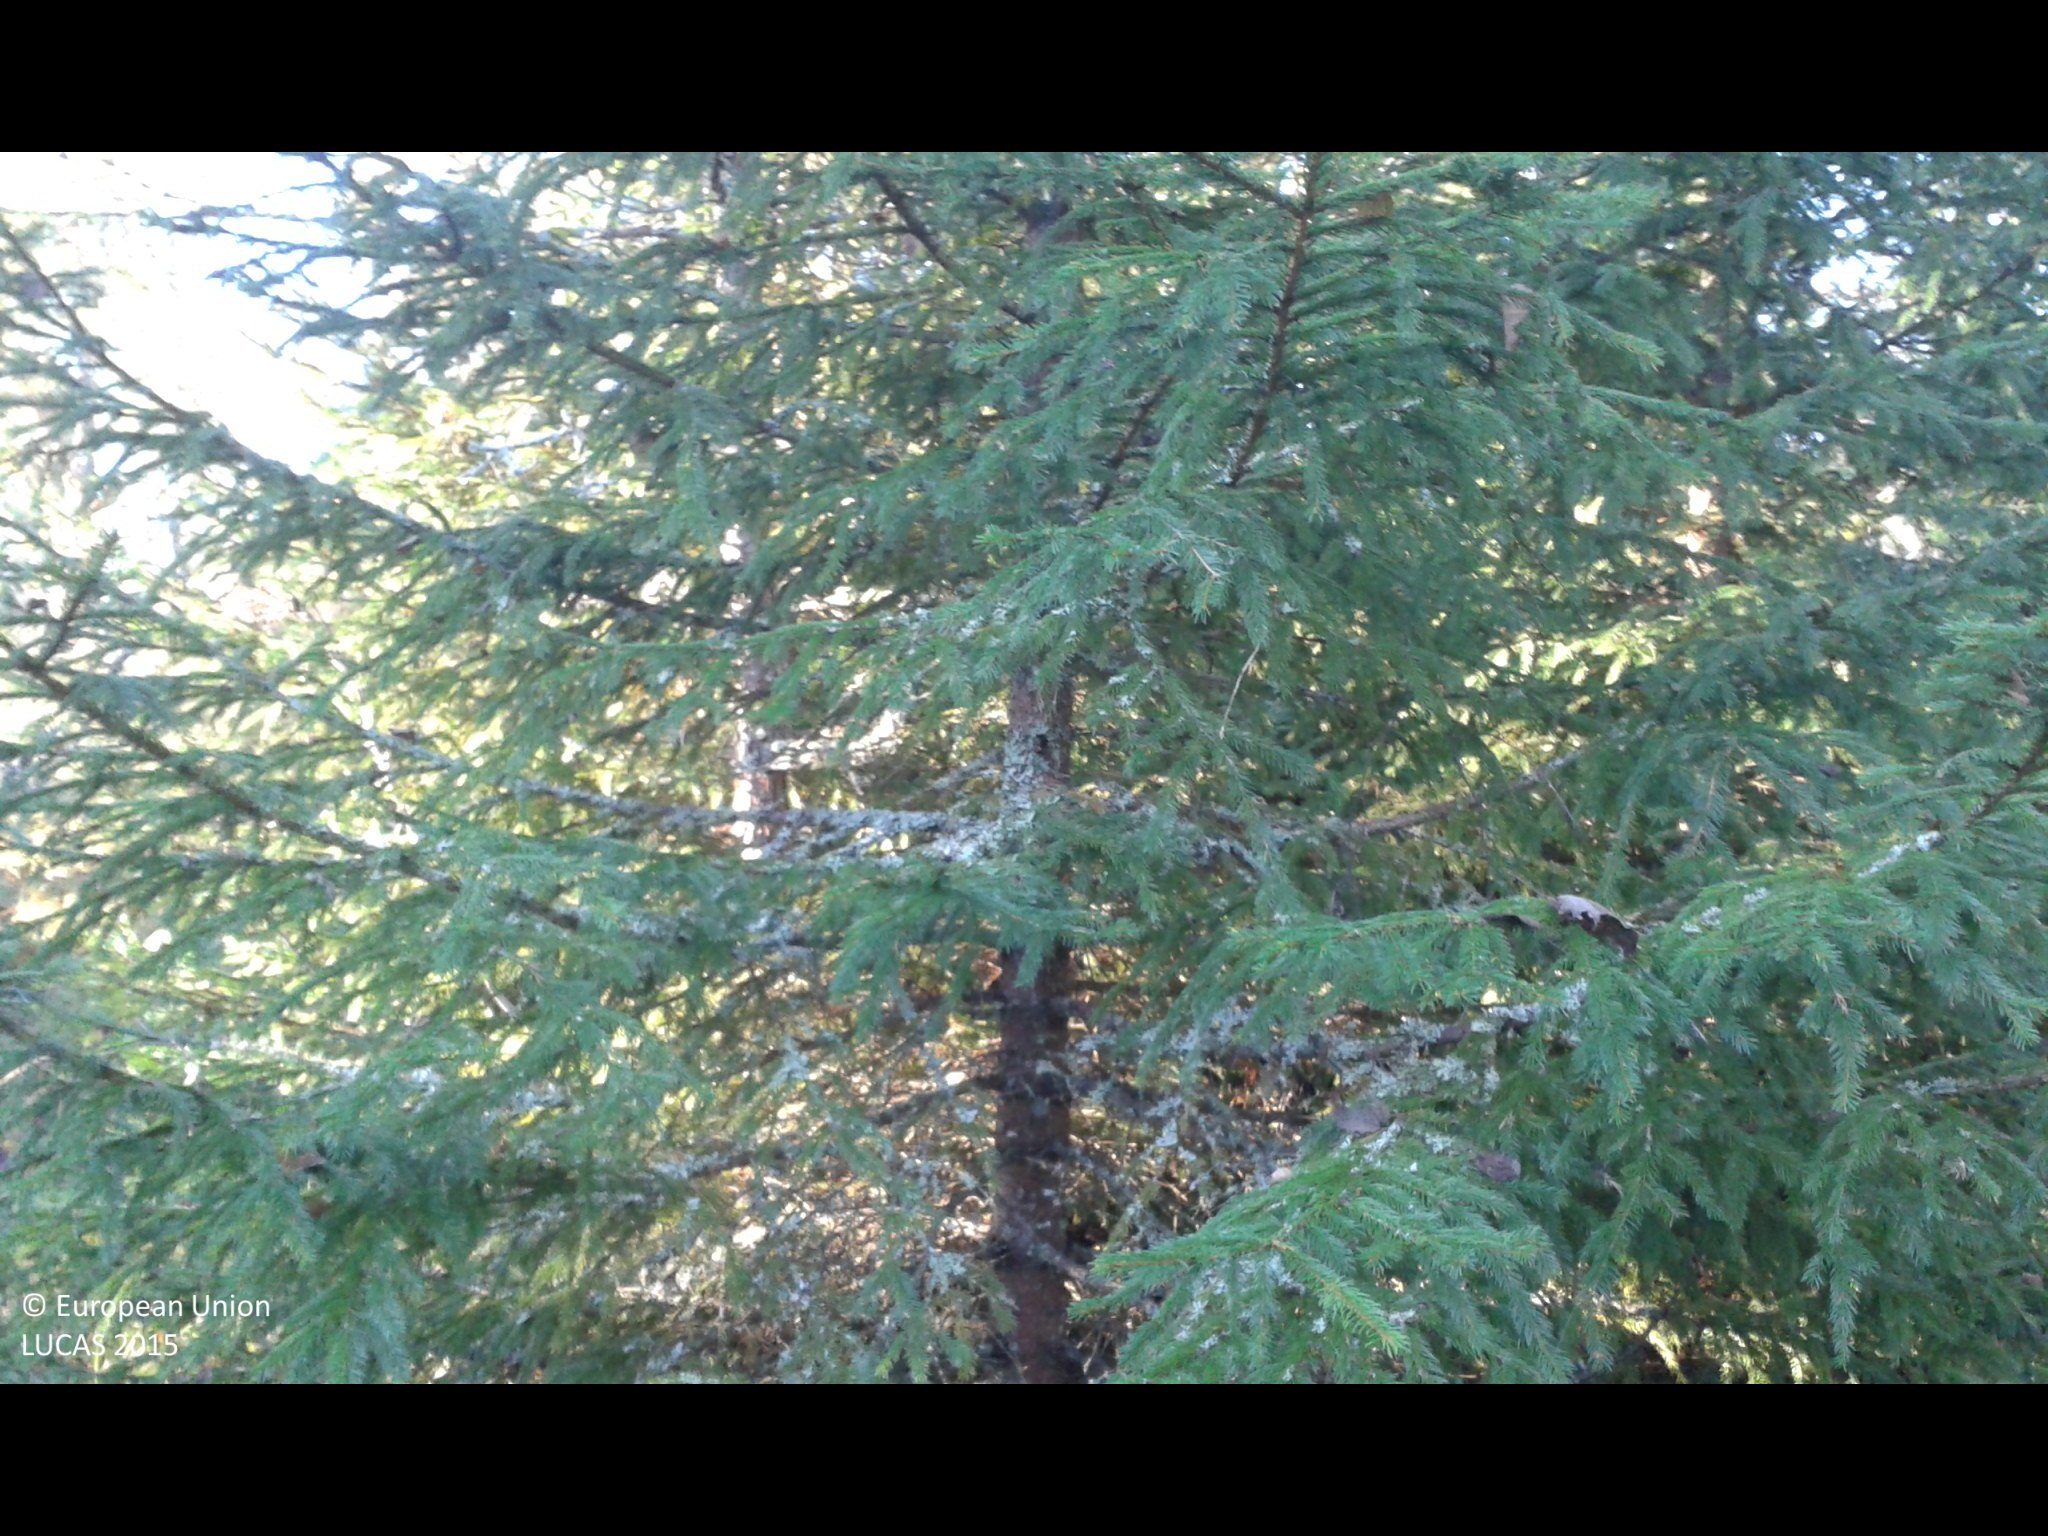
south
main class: Woodland
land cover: Spruce dominated mixed woodland
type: hemiboreal forest and nemoral coniferous forest and mixed broadleaved-coniferous forest
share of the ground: > 75 %
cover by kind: broadleaved forest trees 60 %, coniferous forest trees 20 %, shrubs 10 %, lichens and mosses 10 %
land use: Forestry
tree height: > 5 m
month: September
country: SE
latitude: 59.0578
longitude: 17.5126
